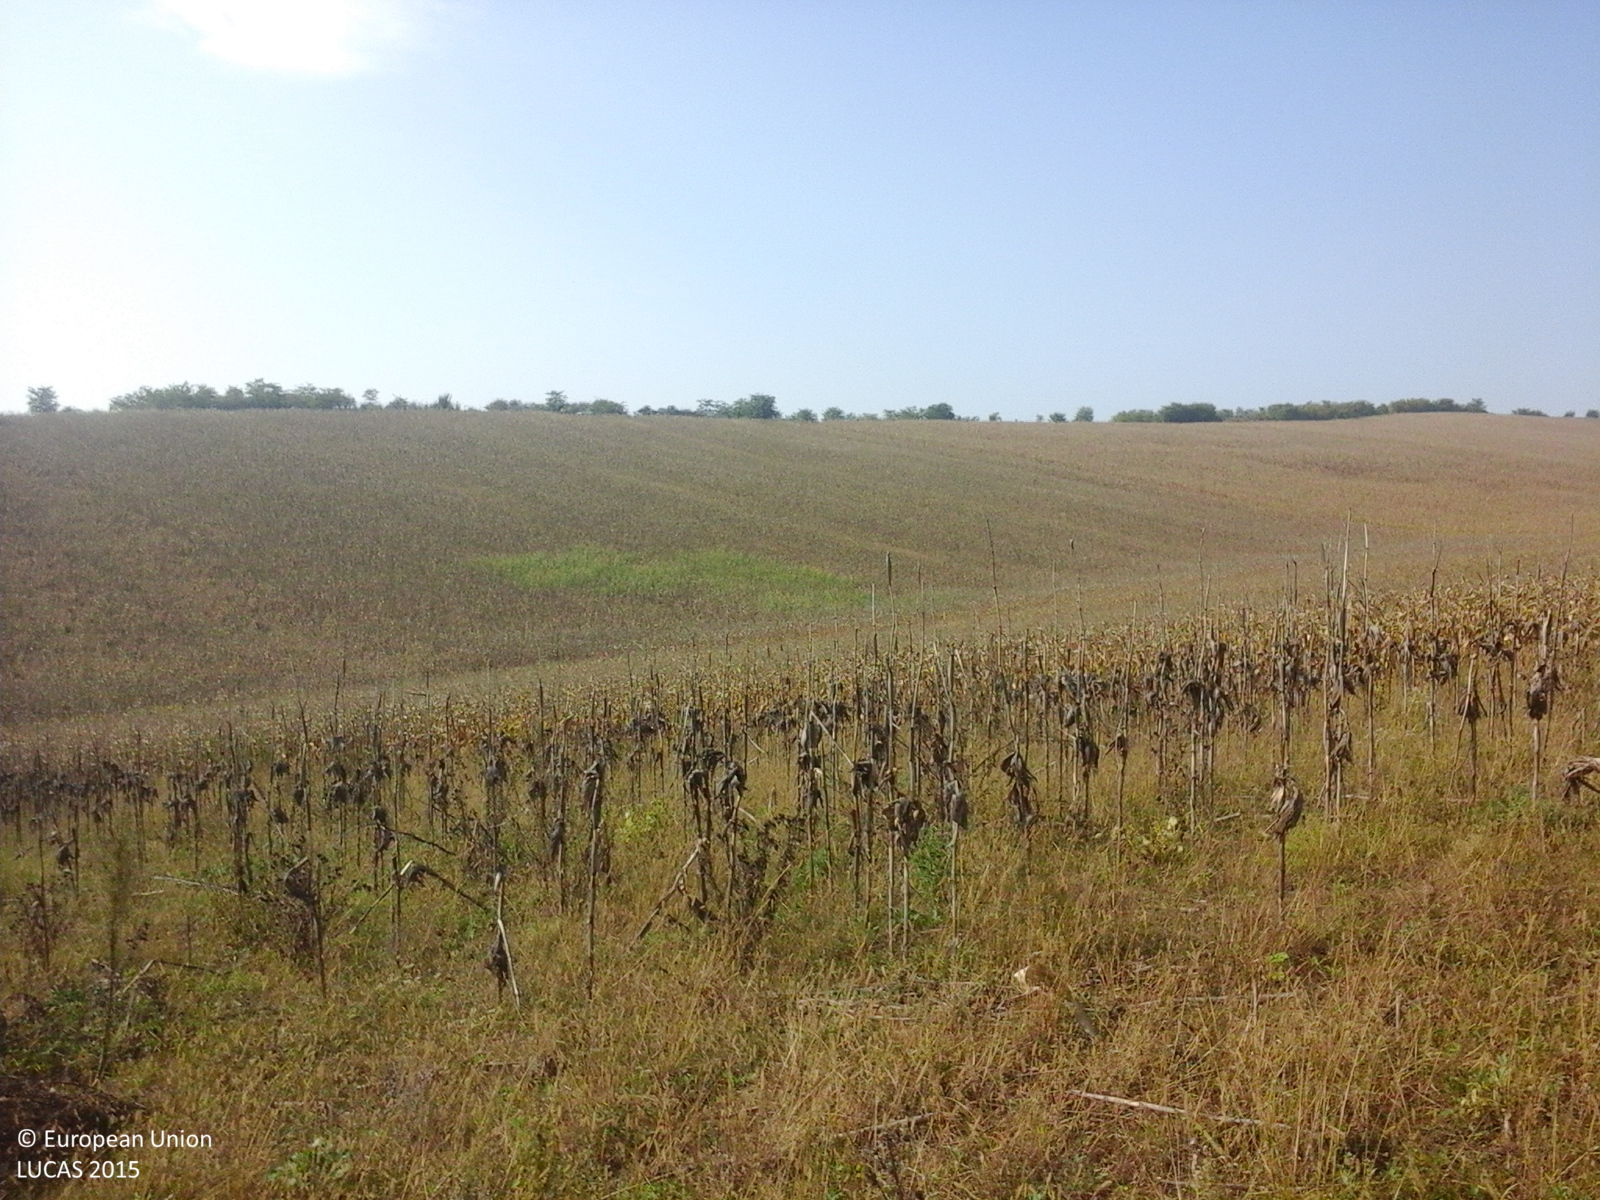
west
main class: Grassland
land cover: Spontaneously vegetated surfaces
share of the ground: > 75 %
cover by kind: herbaceous plants 100 %
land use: Agriculture (excluding fallow land and kitchen gardens)
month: October
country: RO
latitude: 46.6720
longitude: 24.2391
